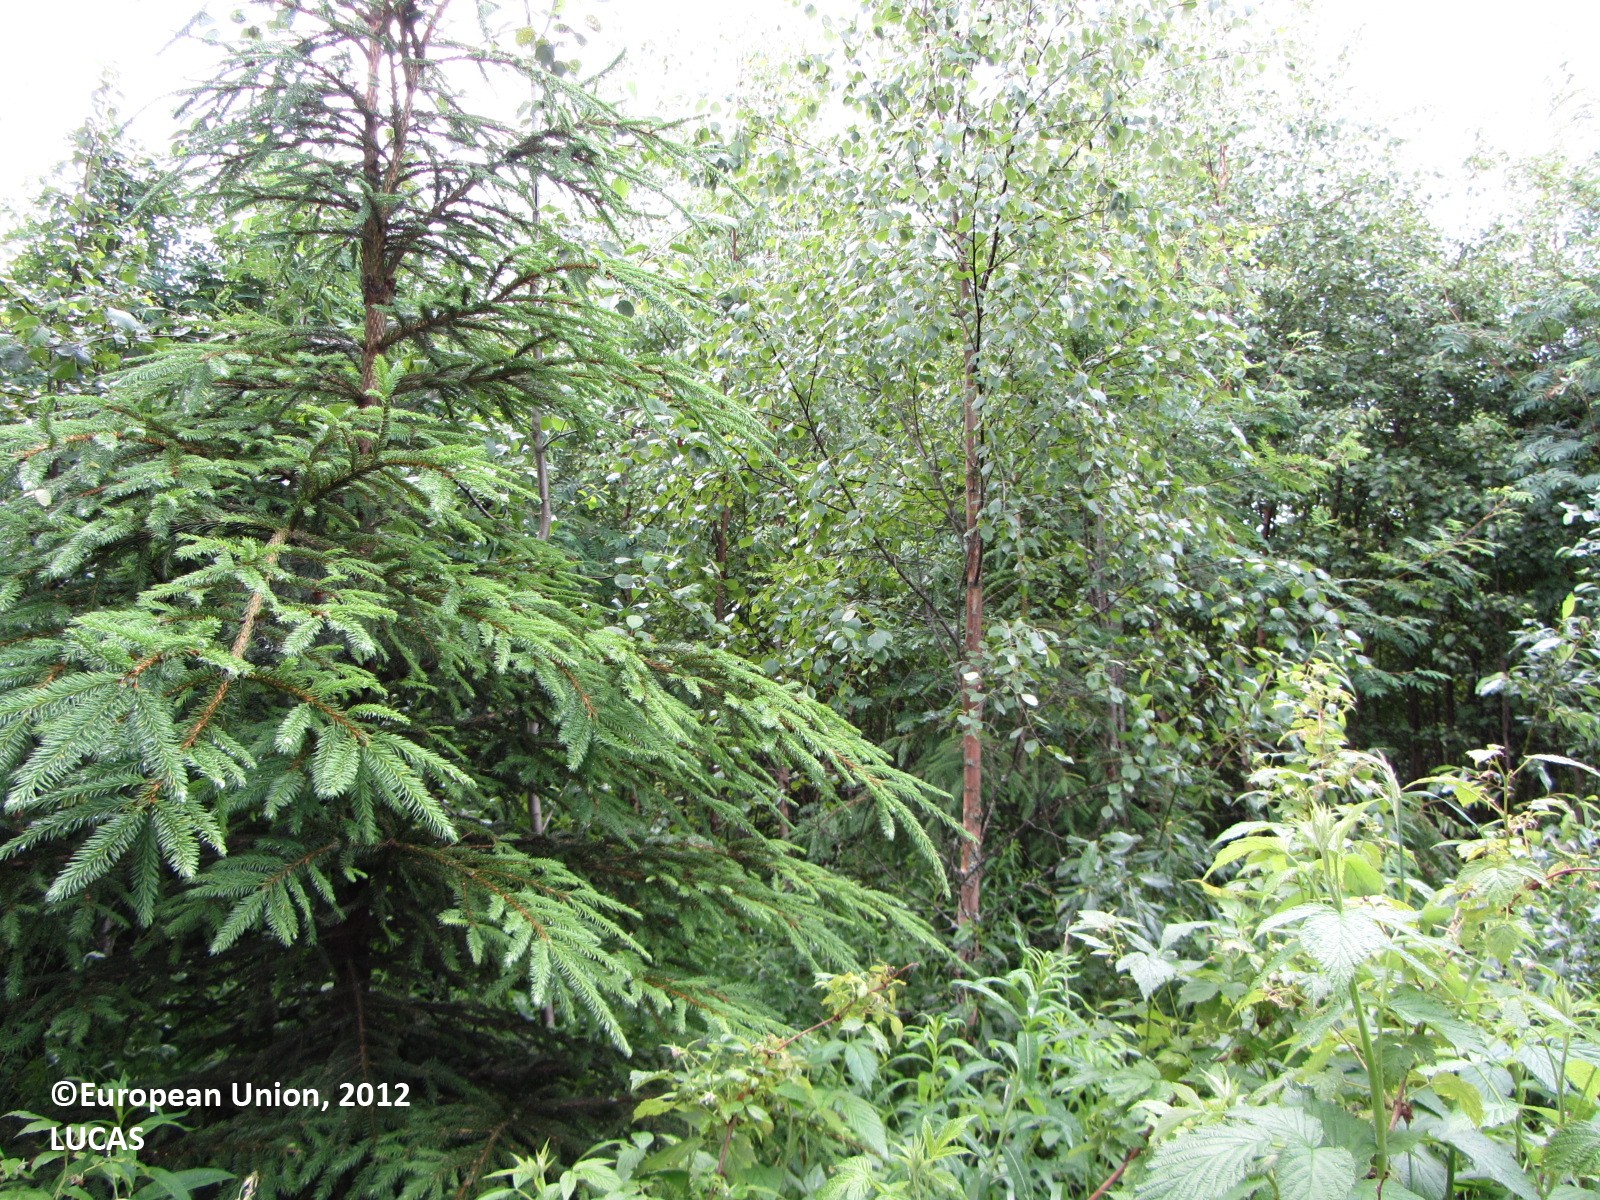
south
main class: Woodland
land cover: Broadleaved woodland
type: boreal forest
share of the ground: 50 - 75 %
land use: Forestry
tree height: > 5 m
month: July
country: FI
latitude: 63.8092
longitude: 25.5532
